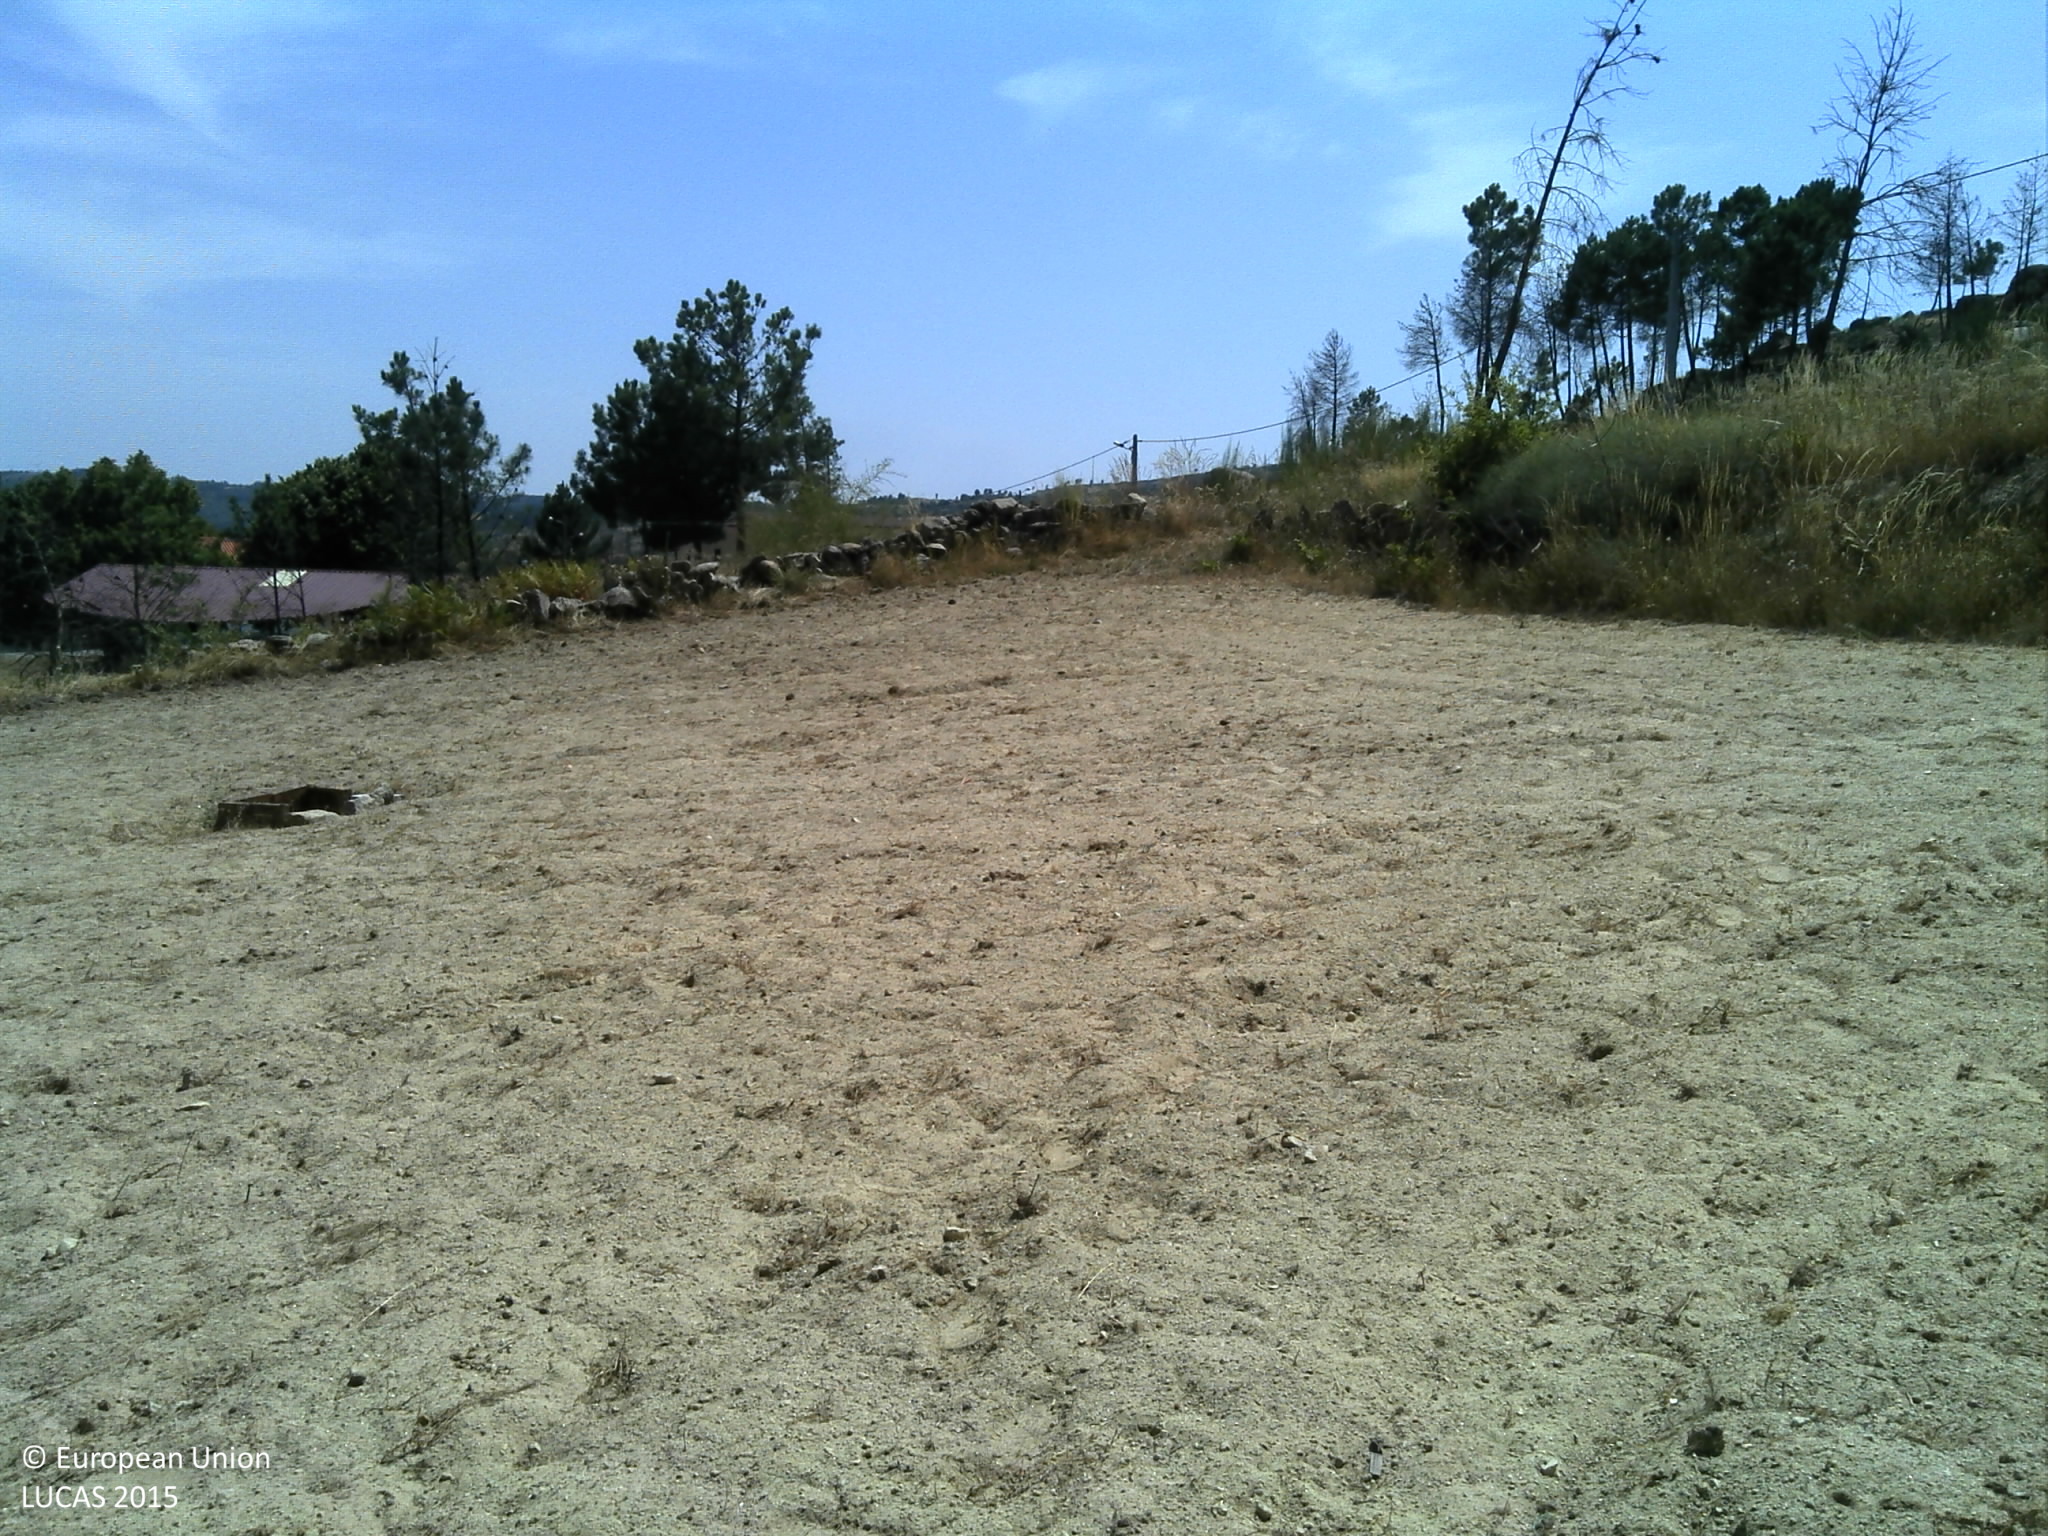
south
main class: Cropland
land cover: Olive groves
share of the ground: 10 - 25 %
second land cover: Other bare soil
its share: > 75 %
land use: Agriculture (excluding fallow land and kitchen gardens)
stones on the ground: 10 - 25 %
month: July
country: PT
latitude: 40.8176
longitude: -7.3145
